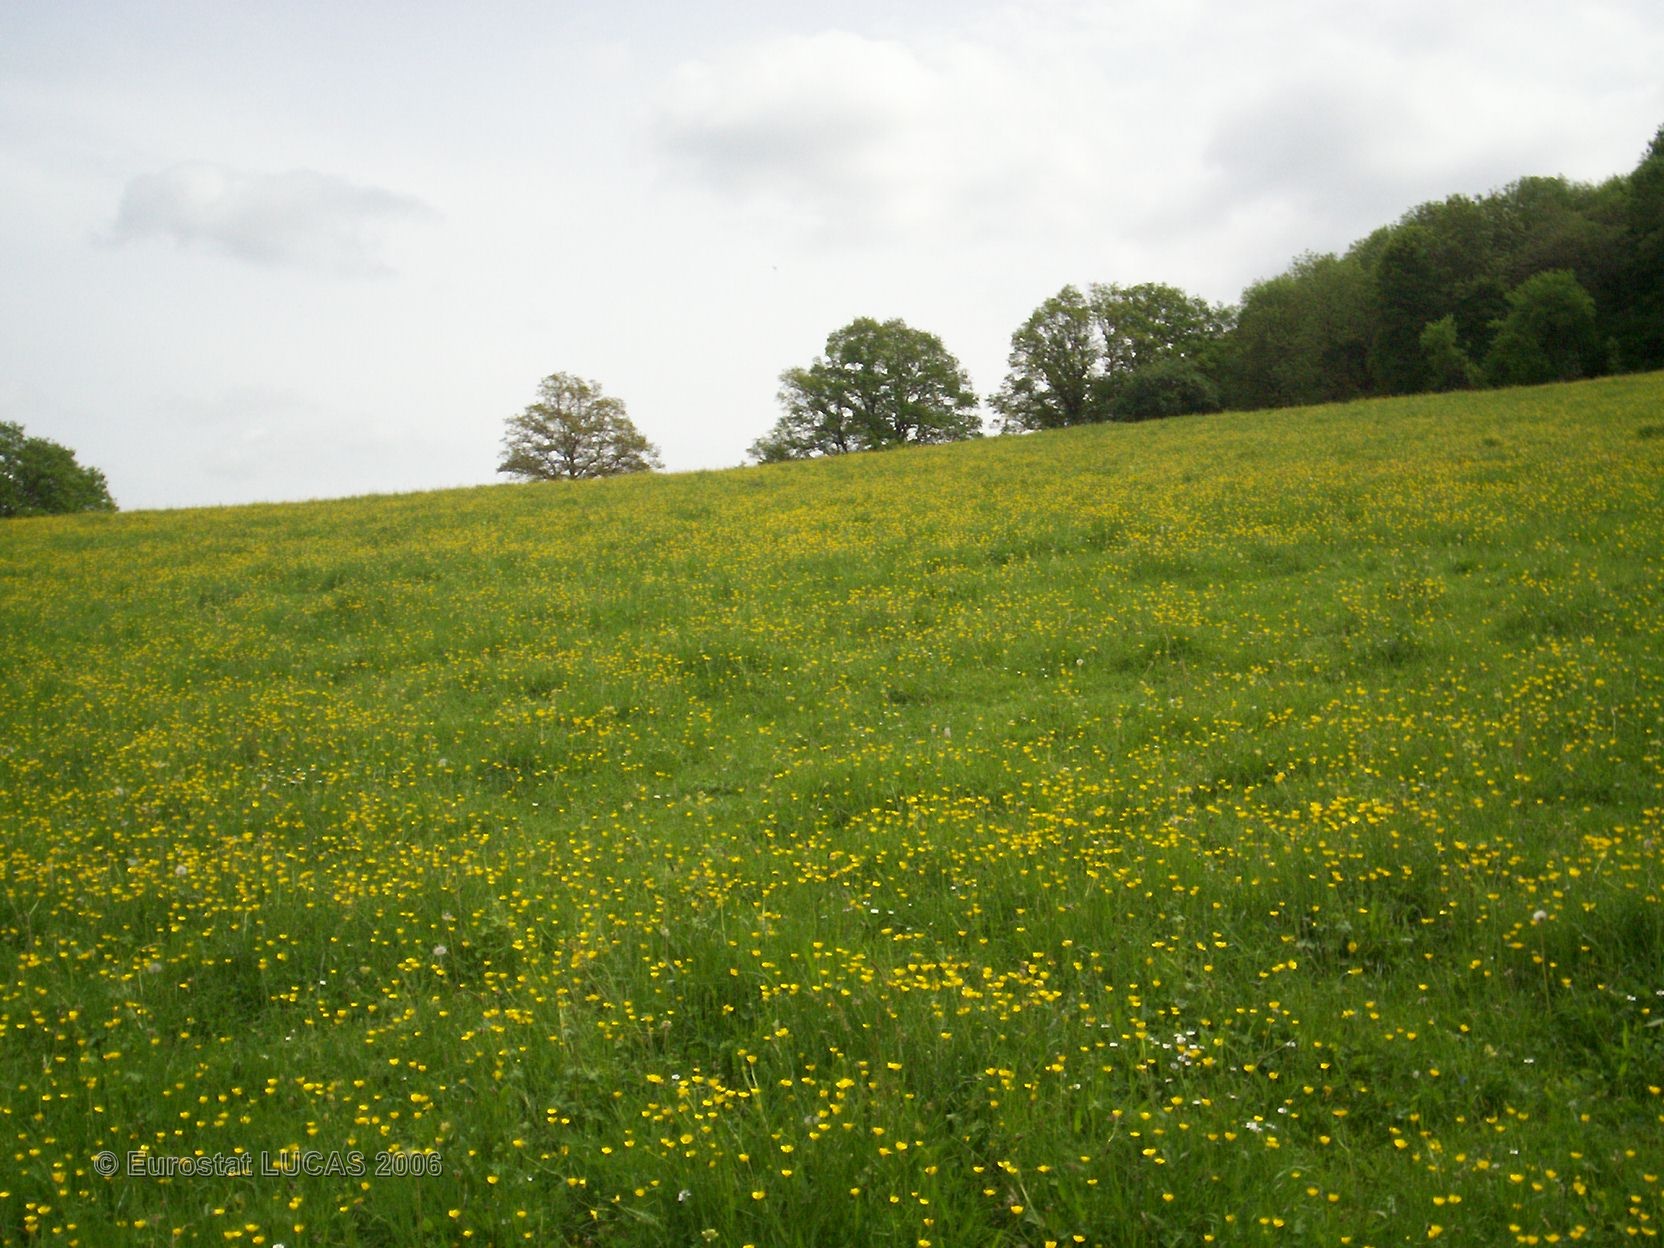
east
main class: Grassland
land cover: Grassland without tree/shrub cover
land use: Agriculture (excluding fallow land and kitchen gardens)
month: May
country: FR
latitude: 47.3137
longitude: 4.5627
